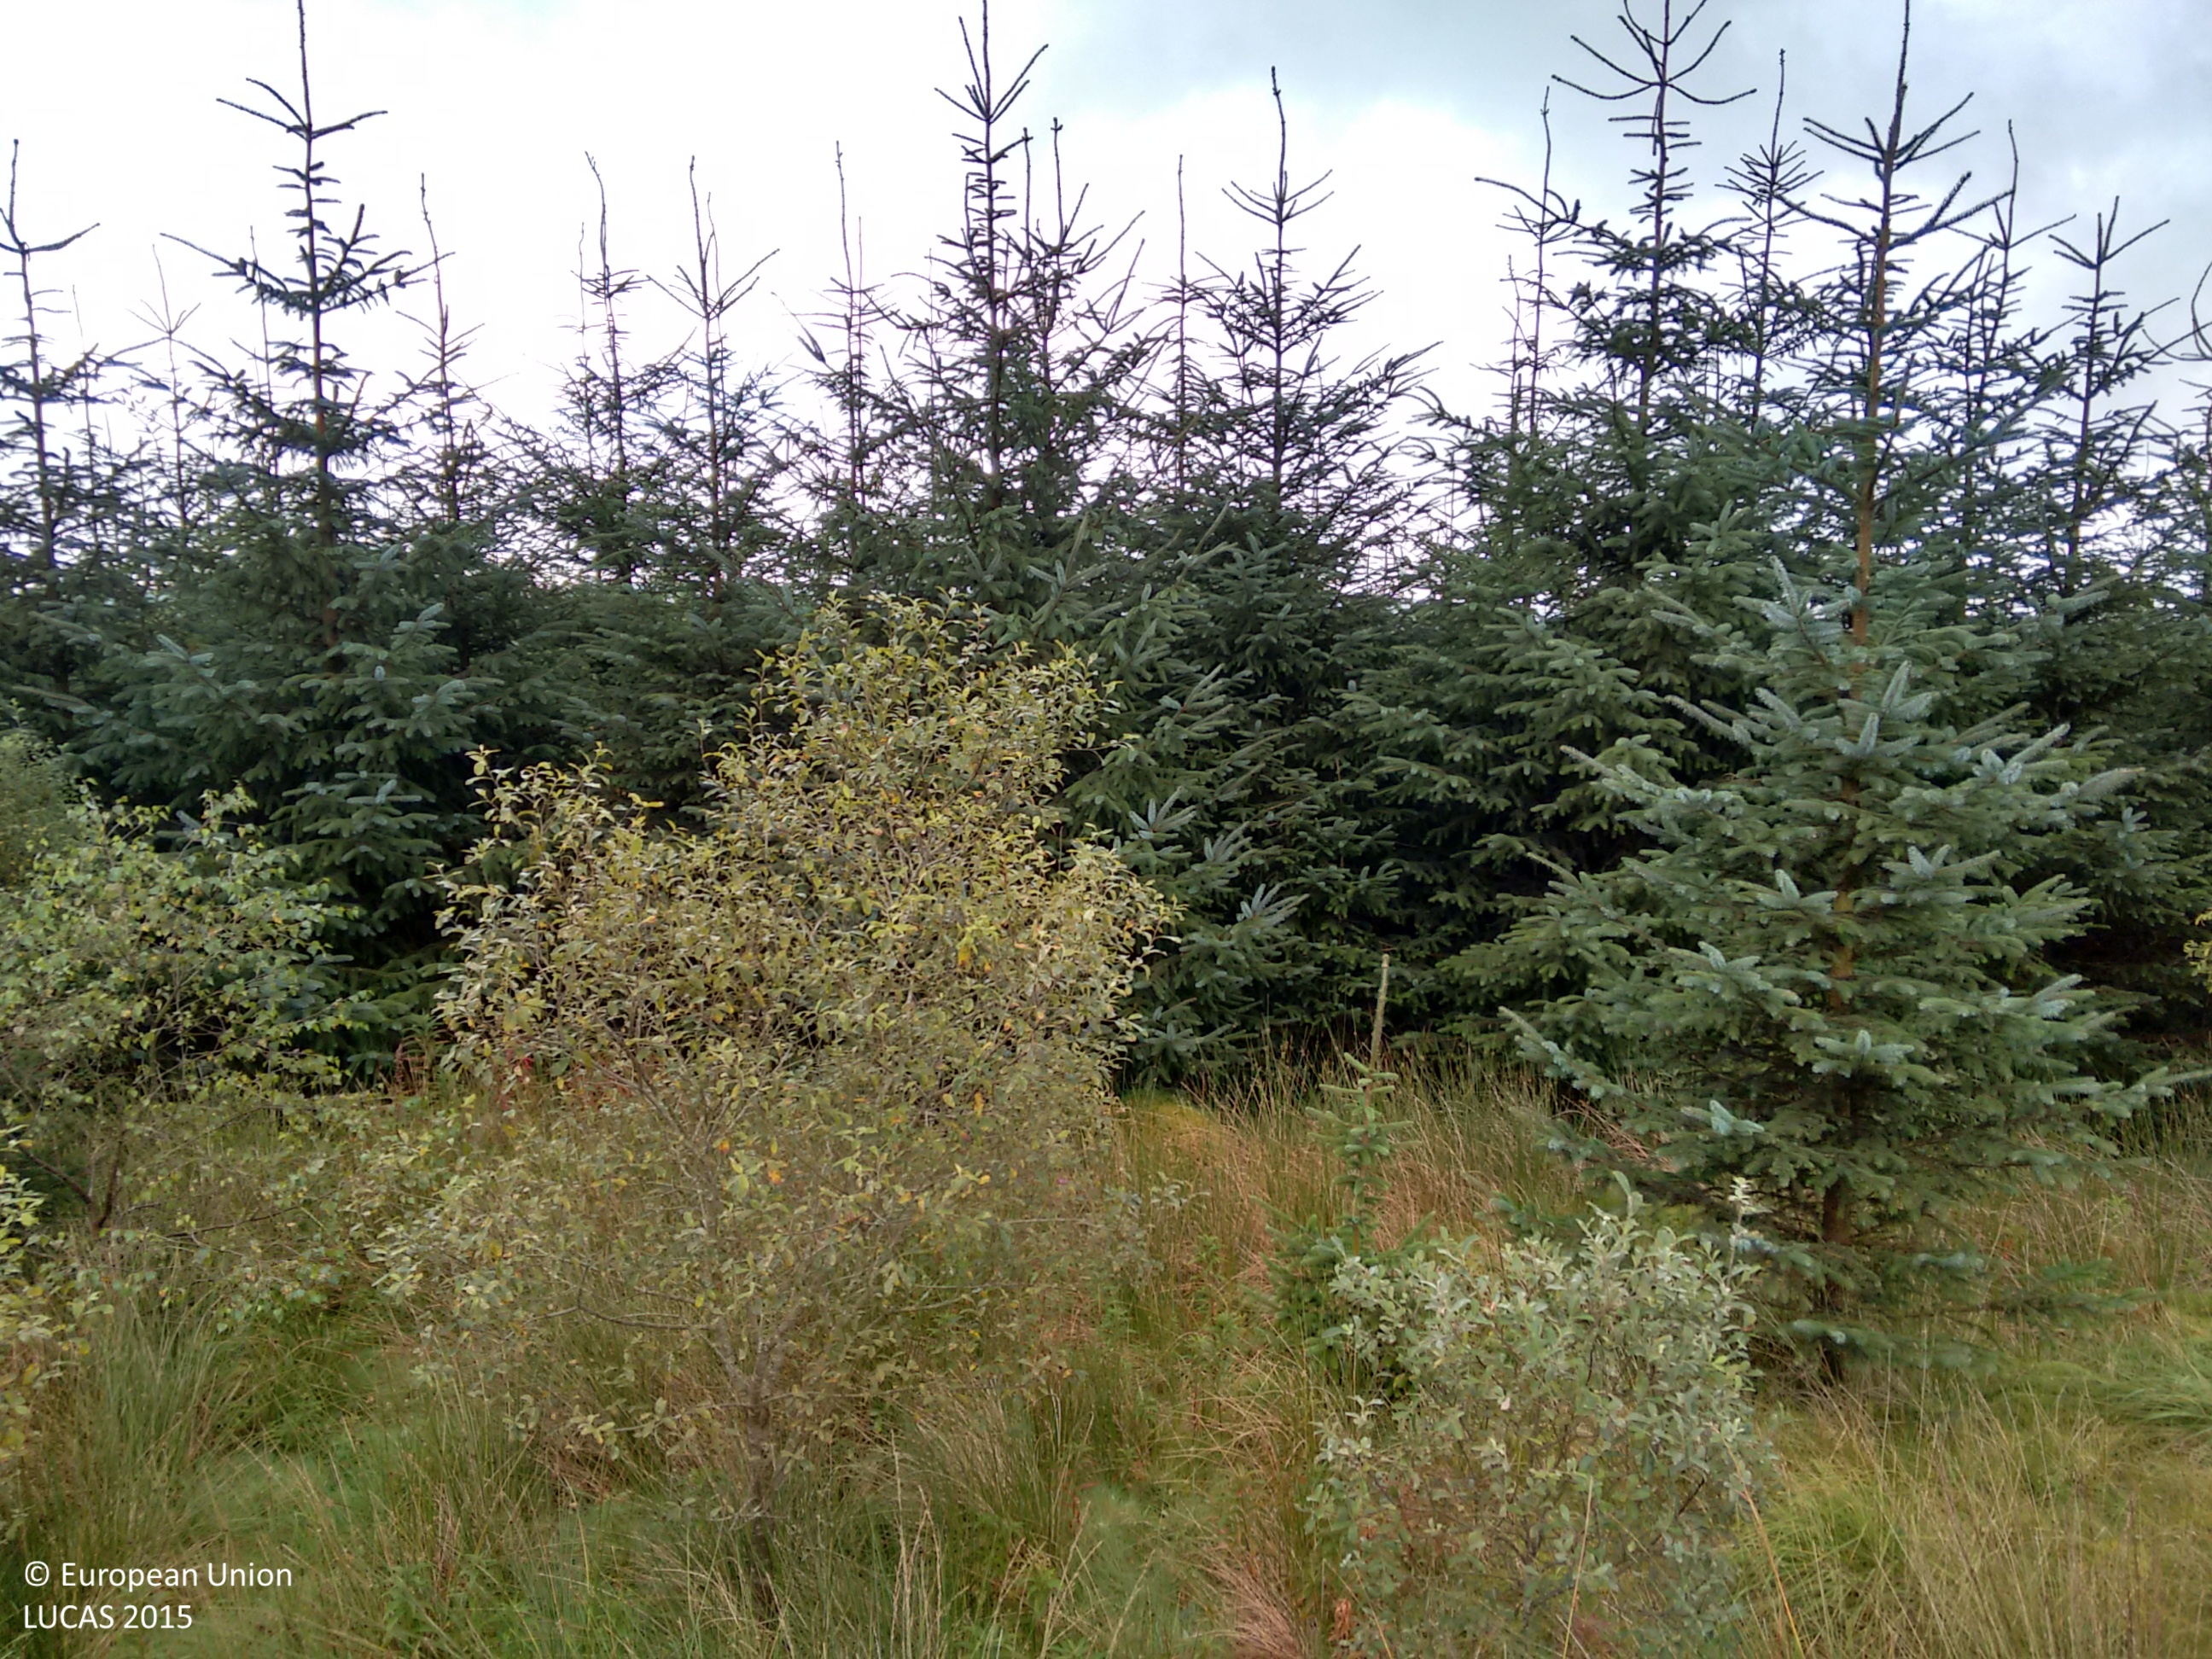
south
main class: Woodland
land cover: Spruce dominated coniferous woodland
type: exotic forest
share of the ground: > 75 %
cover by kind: coniferous forest trees 70 %, herbaceous plants 30 %
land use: Forestry
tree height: < 5 m
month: September
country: GB
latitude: 52.1589
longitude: -3.7273
